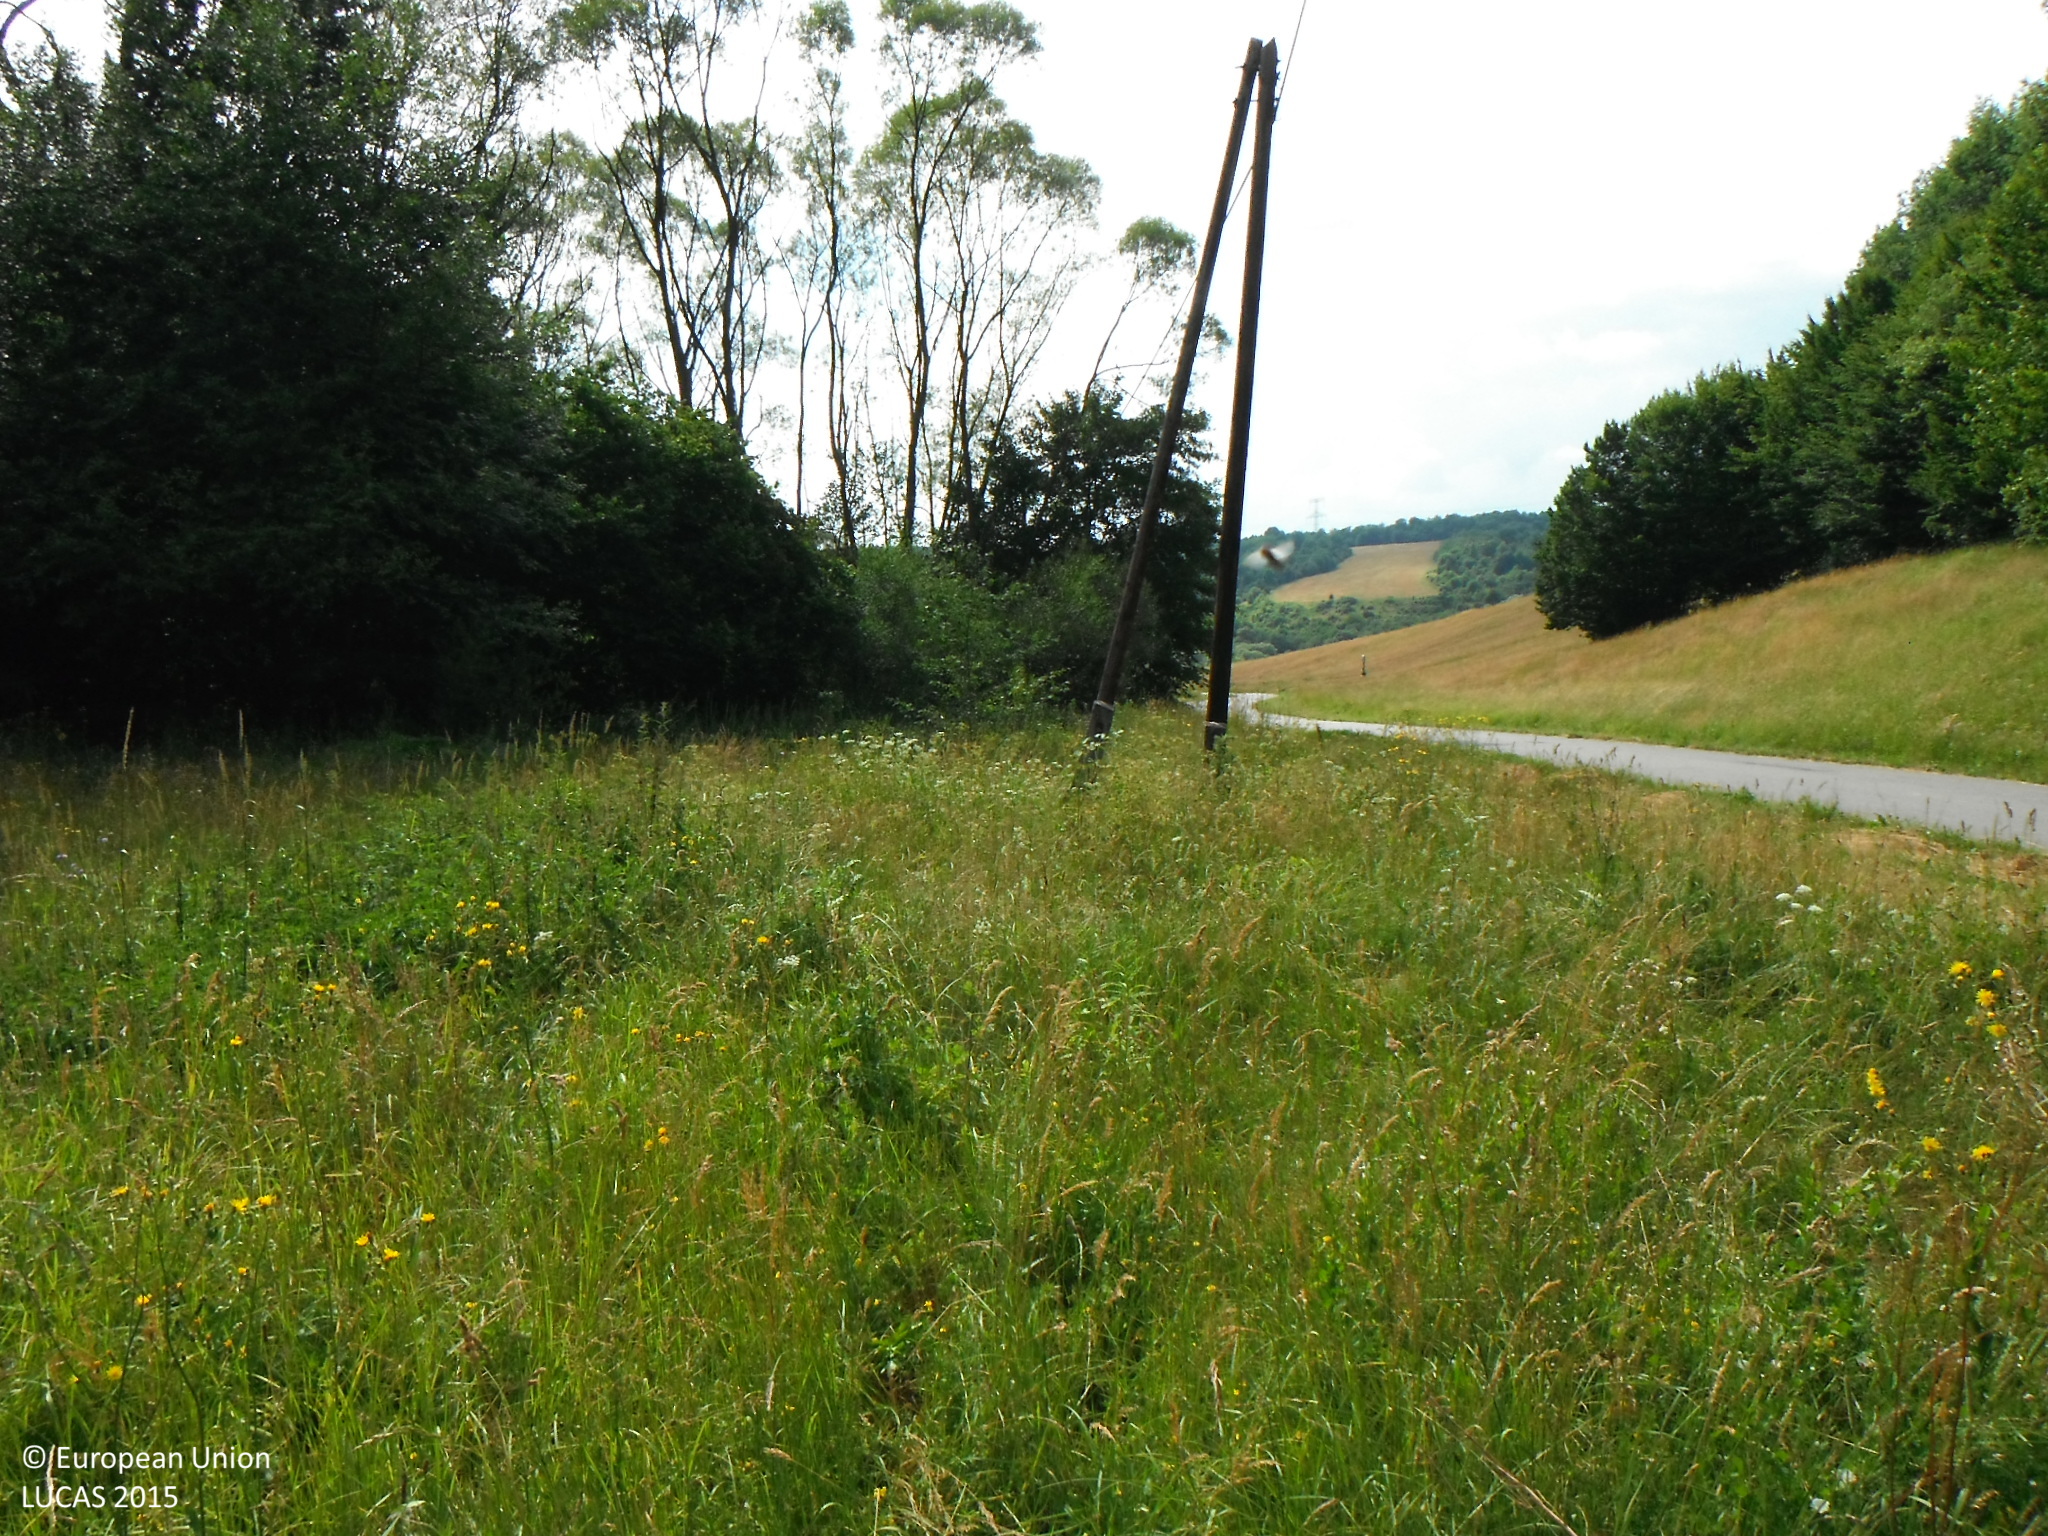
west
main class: Grassland
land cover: Grassland without tree/shrub cover
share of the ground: > 75 %
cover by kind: herbaceous plants 100 %
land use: Agriculture (excluding fallow land and kitchen gardens)
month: June
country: SK
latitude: 49.3478
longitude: 21.6554
